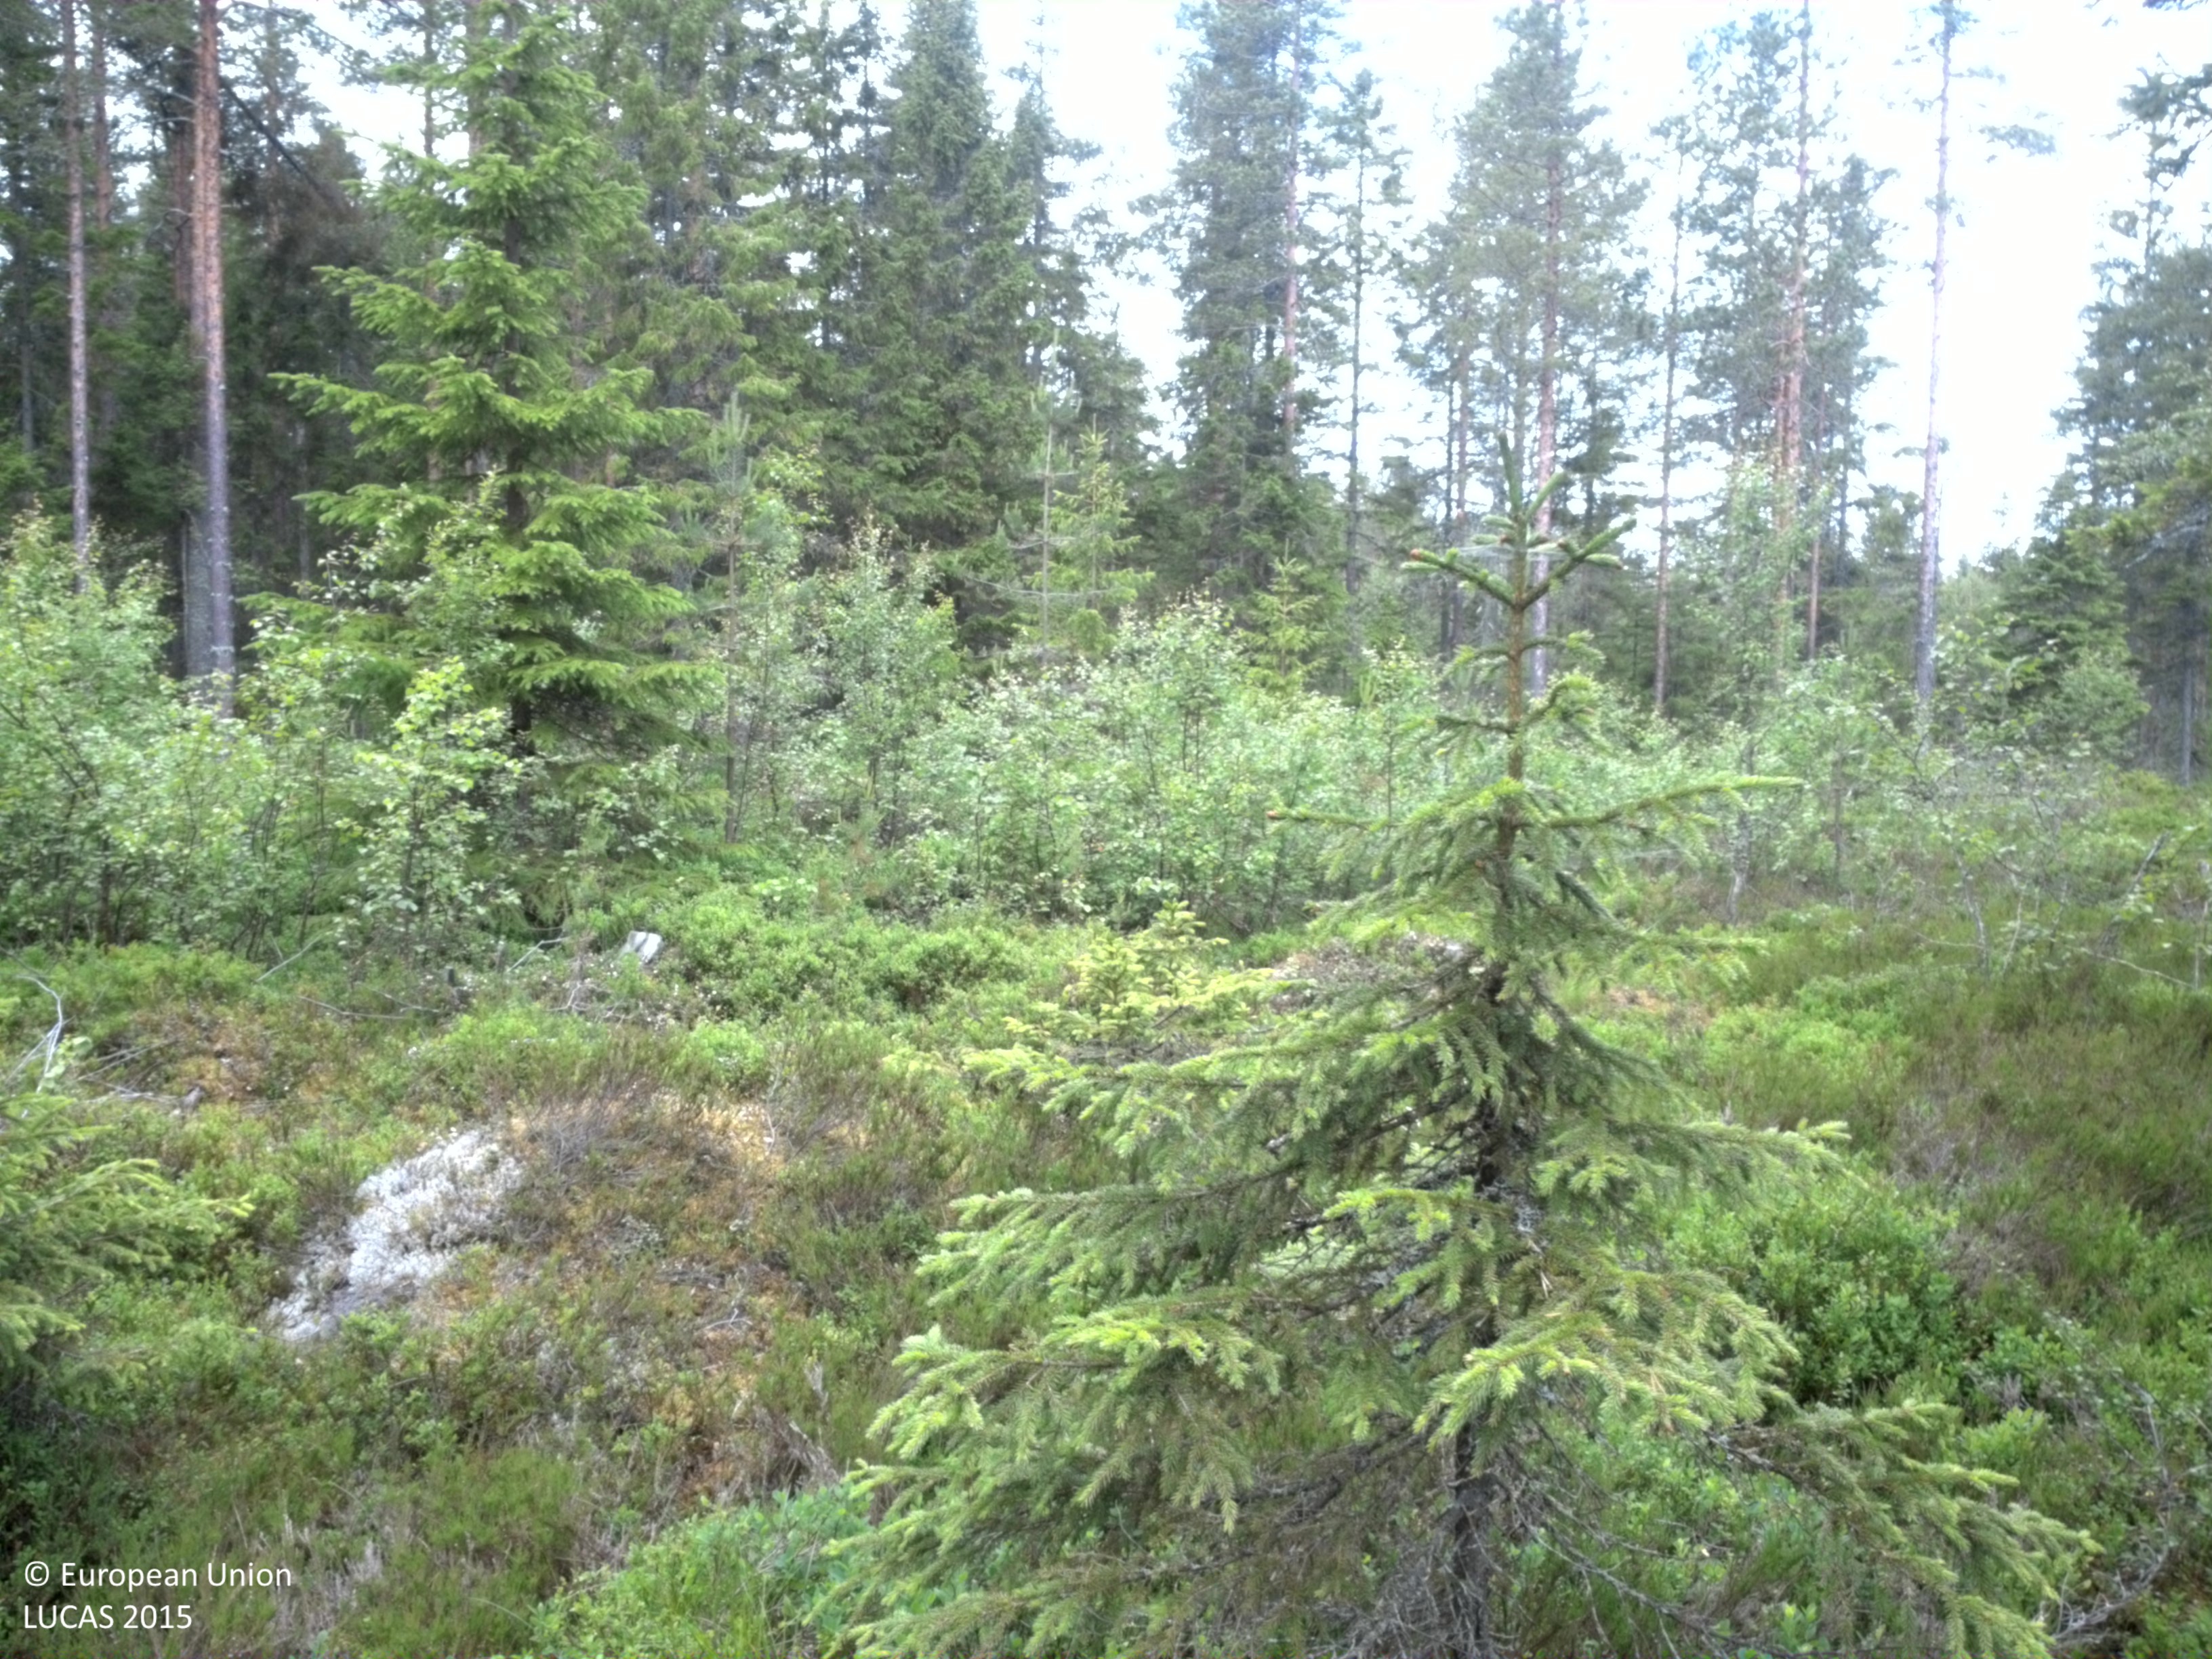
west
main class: Woodland
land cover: Pine dominated coniferous woodland
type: mire and swamp forests
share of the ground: 25 - 50 %
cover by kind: coniferous forest trees 50 %, shrubs 50 %
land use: Forestry
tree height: > 5 m
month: July
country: SE
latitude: 64.3816
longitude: 21.2399
